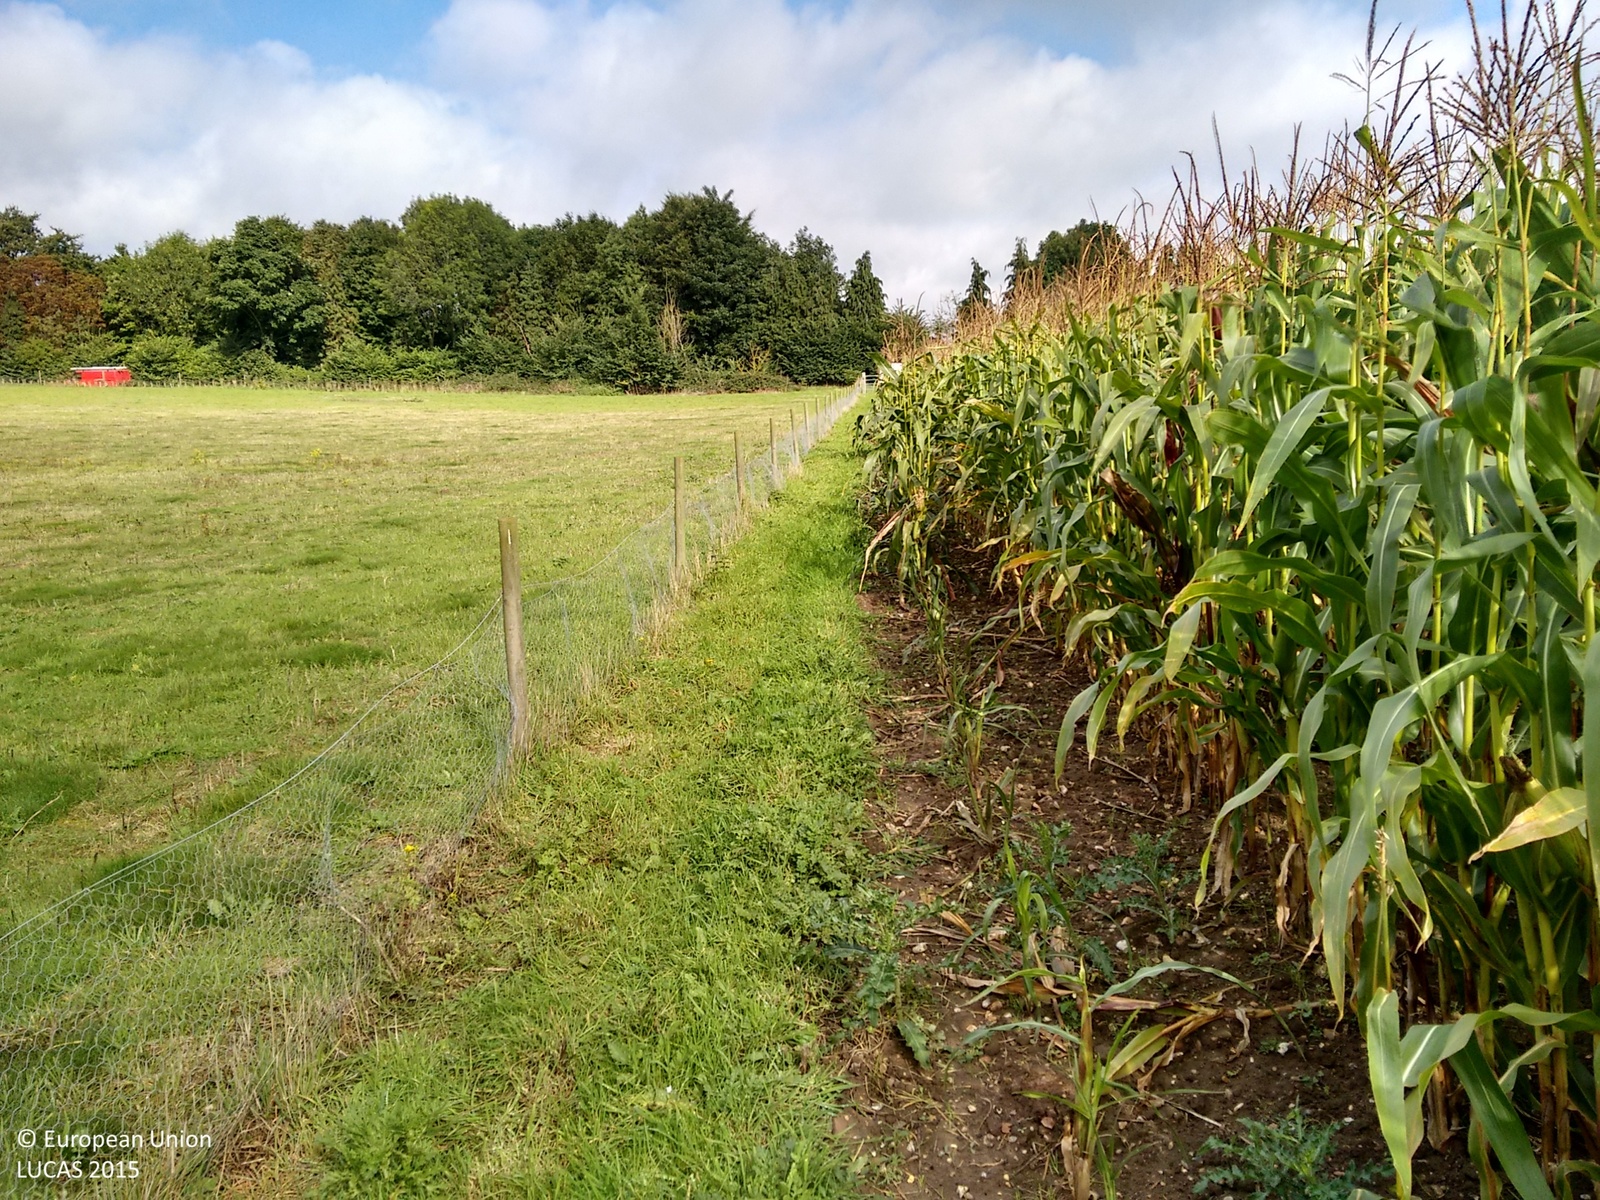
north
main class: Woodland
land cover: Broadleaved woodland
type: mesophytic deciduous forest
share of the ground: > 75 %
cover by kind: broadleaved forest trees 100 %
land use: Forestry
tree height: > 5 m
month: September
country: GB
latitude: 52.5404
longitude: 1.4733
